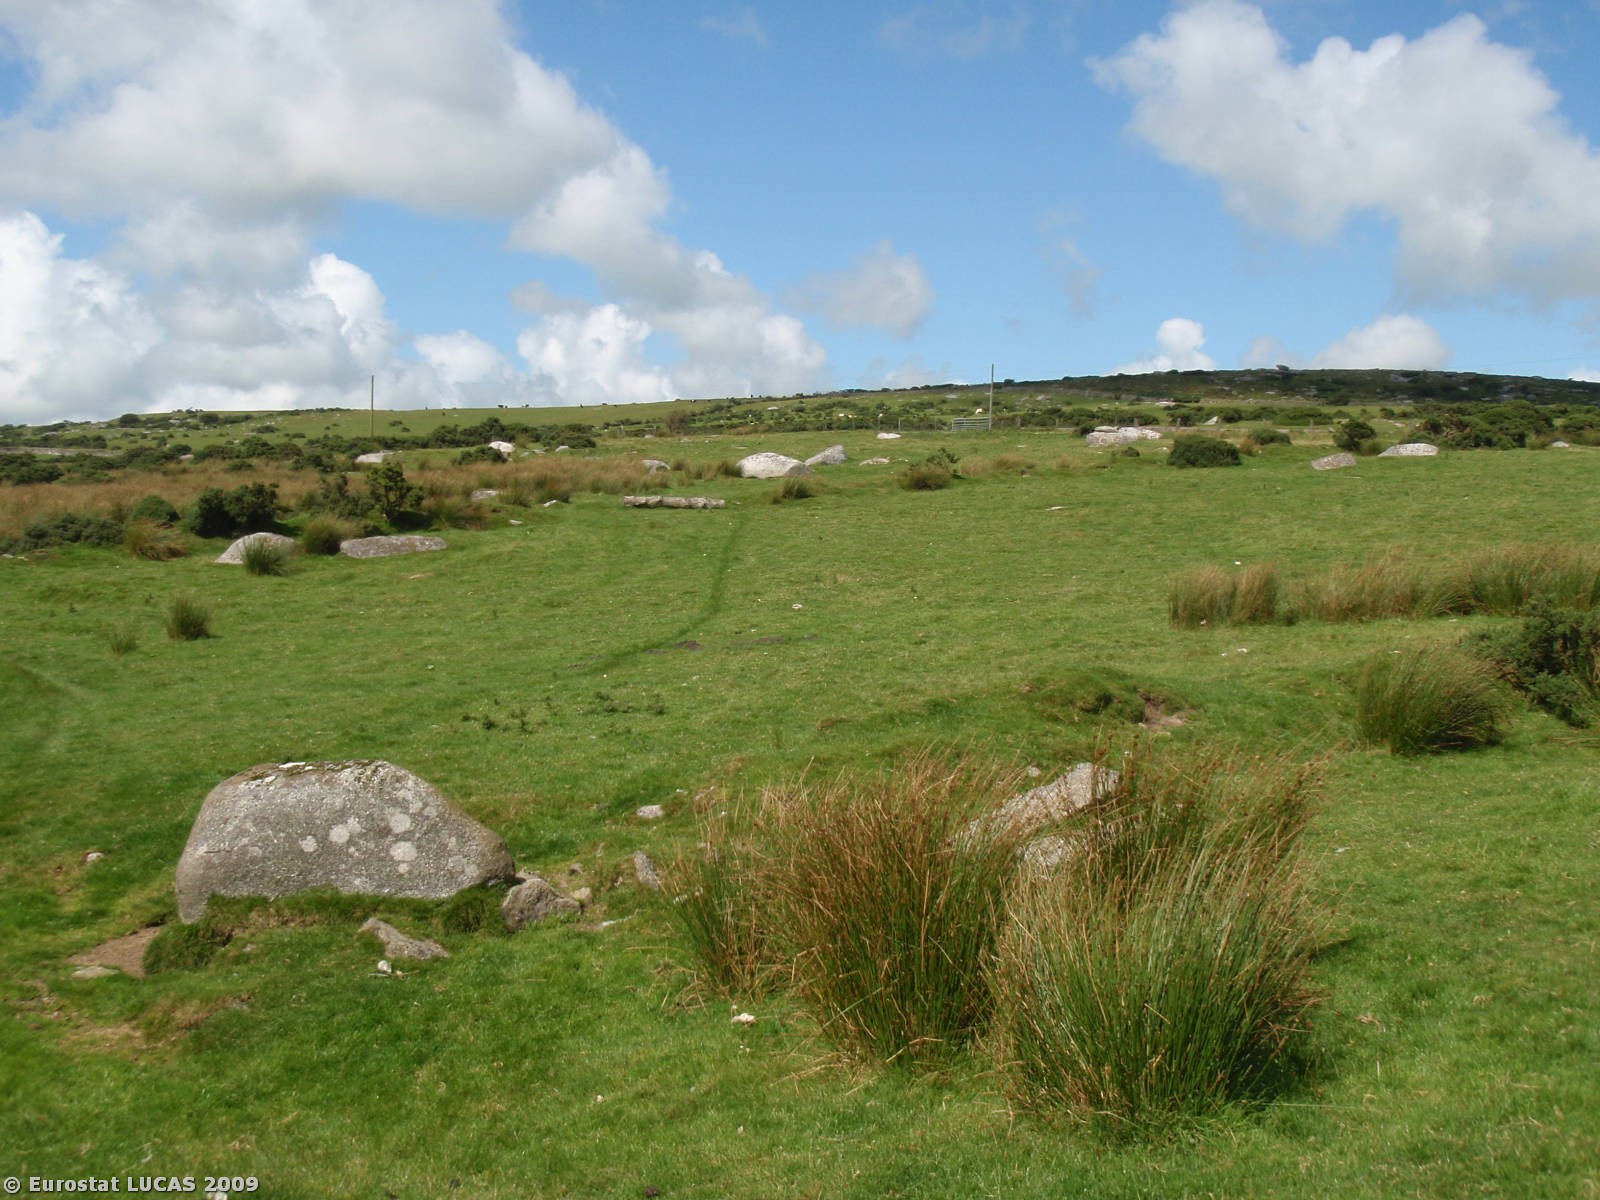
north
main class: Grassland
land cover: Grassland without tree/shrub cover
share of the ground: > 75 %
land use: Agriculture (excluding fallow land and kitchen gardens)
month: August
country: GB
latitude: 50.5783
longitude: -4.5522
